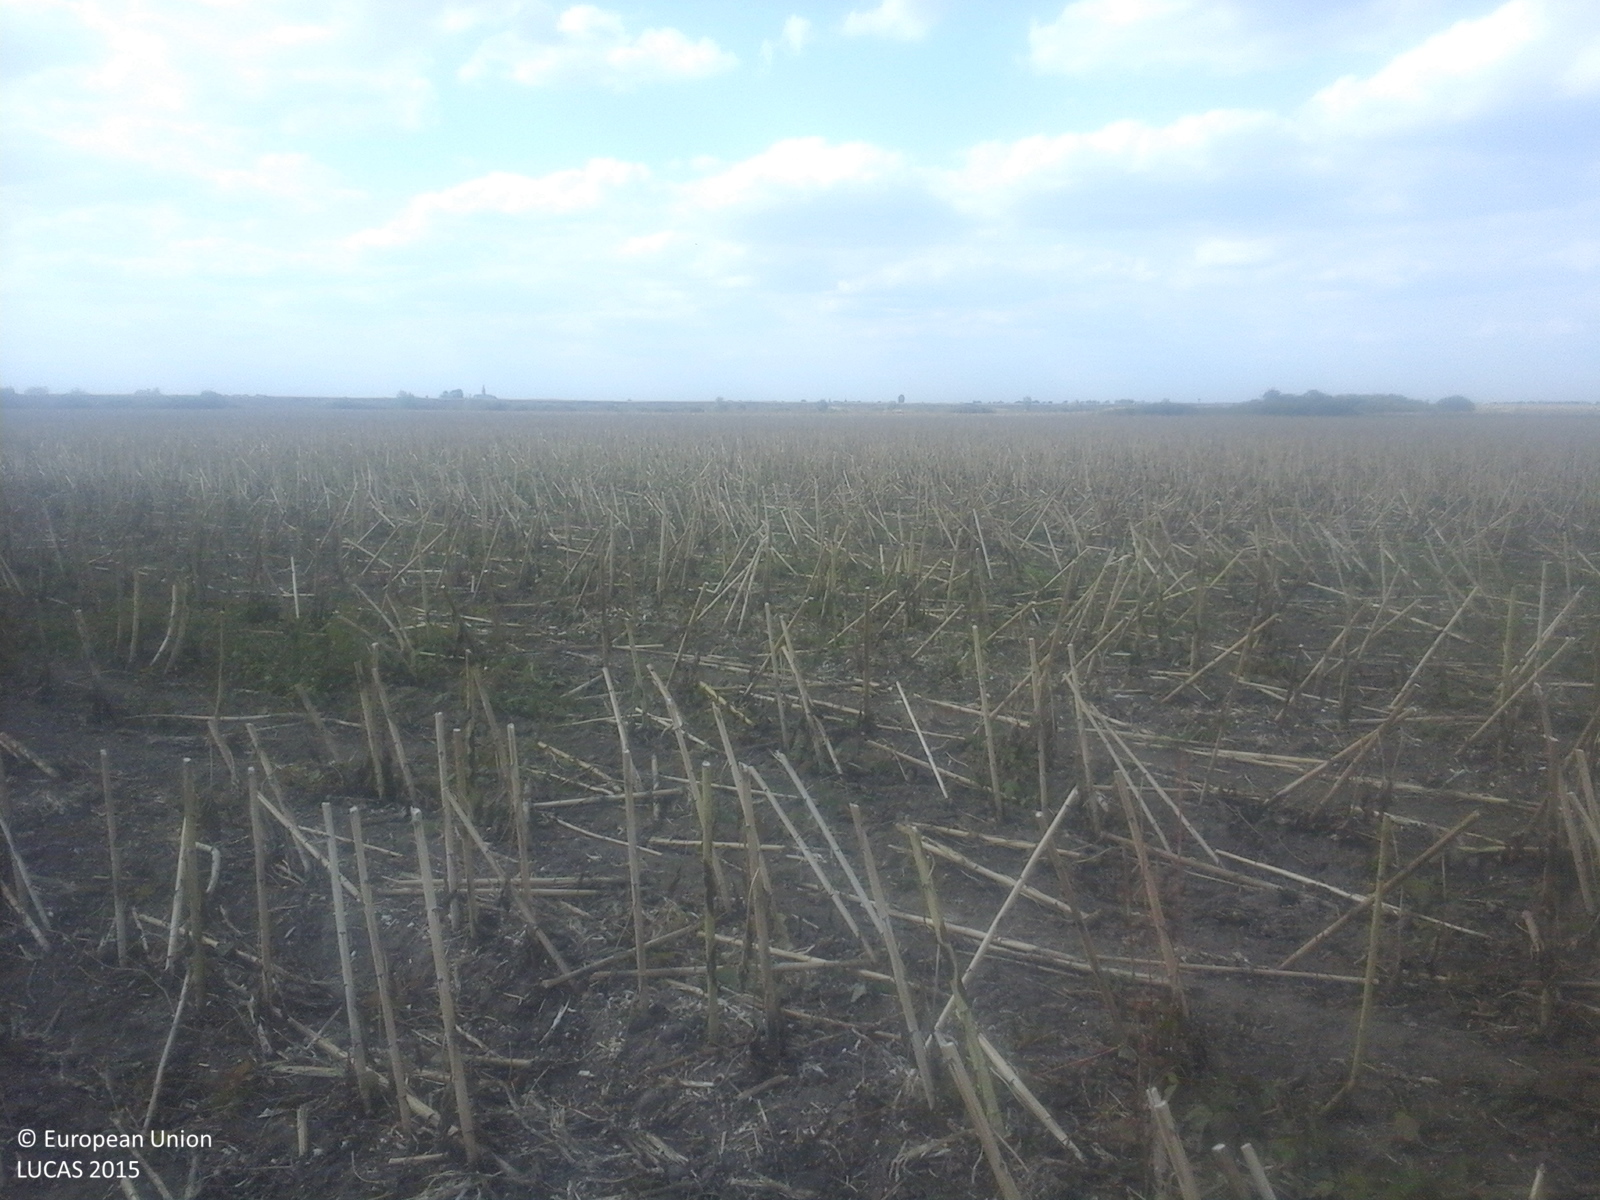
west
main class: Cropland
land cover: Sunflower
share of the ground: > 75 %
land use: Agriculture (excluding fallow land and kitchen gardens)
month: September
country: RO
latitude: 47.6677
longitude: 22.6994
